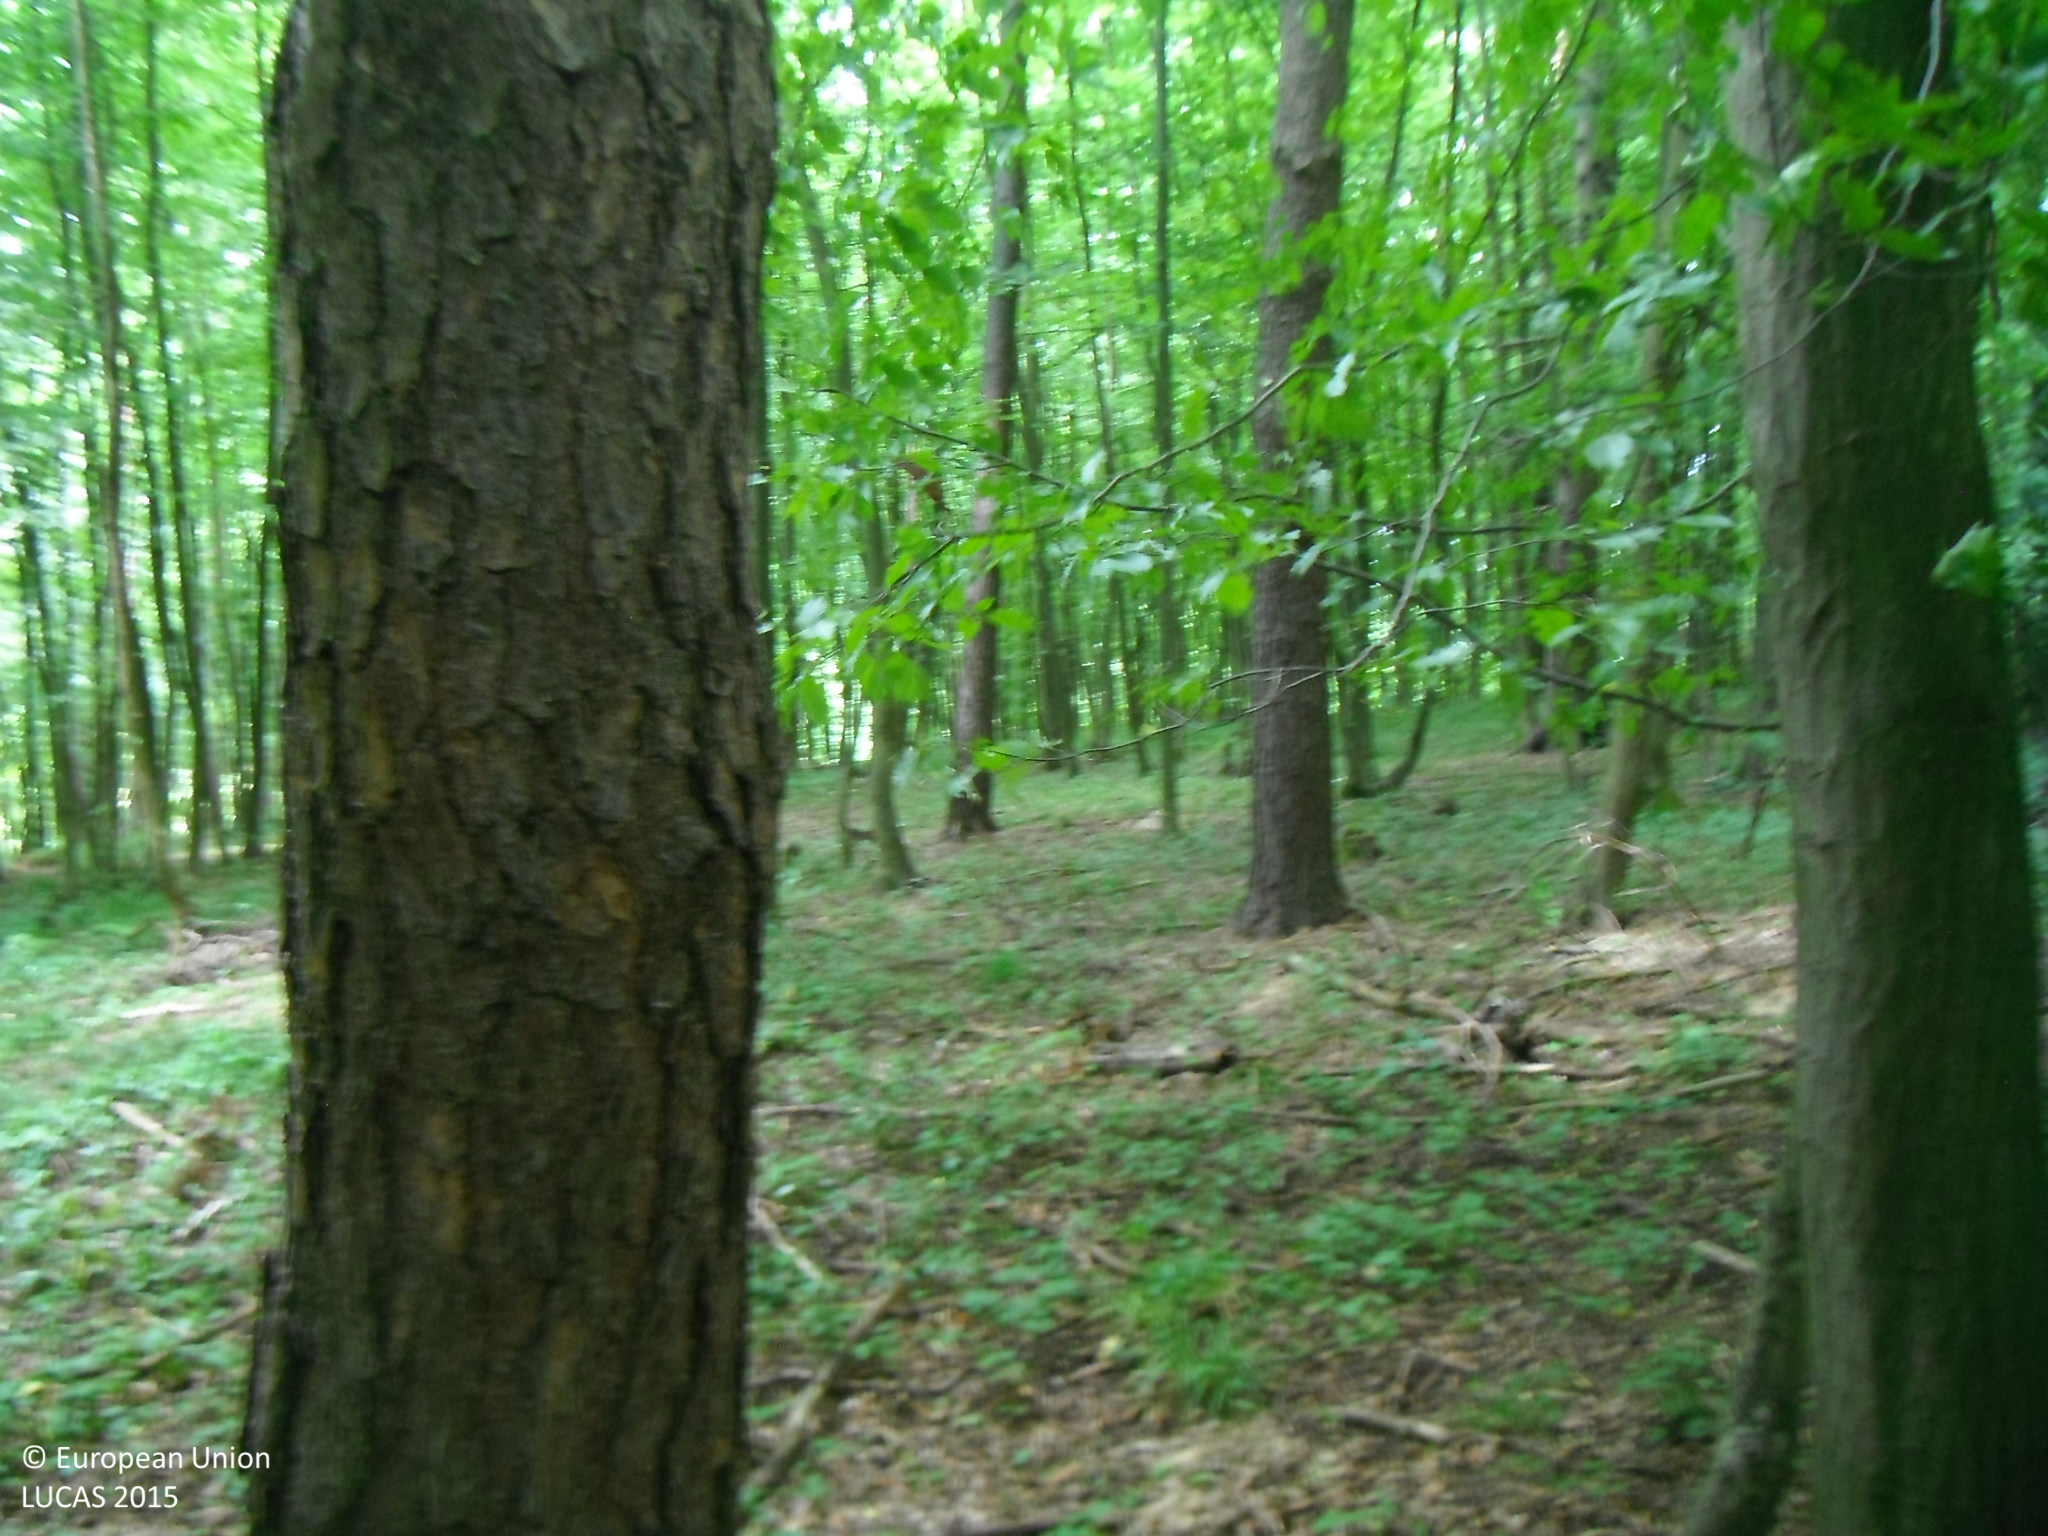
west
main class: Woodland
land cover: Pine dominated mixed woodland
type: hemiboreal forest and nemoral coniferous forest and mixed broadleaved-coniferous forest
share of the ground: > 75 %
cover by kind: coniferous forest trees 45 %, broadleaved forest trees 45 %, herbaceous plants 10 %
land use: Forestry
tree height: > 5 m
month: July
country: SK
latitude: 49.0755
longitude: 18.4365
